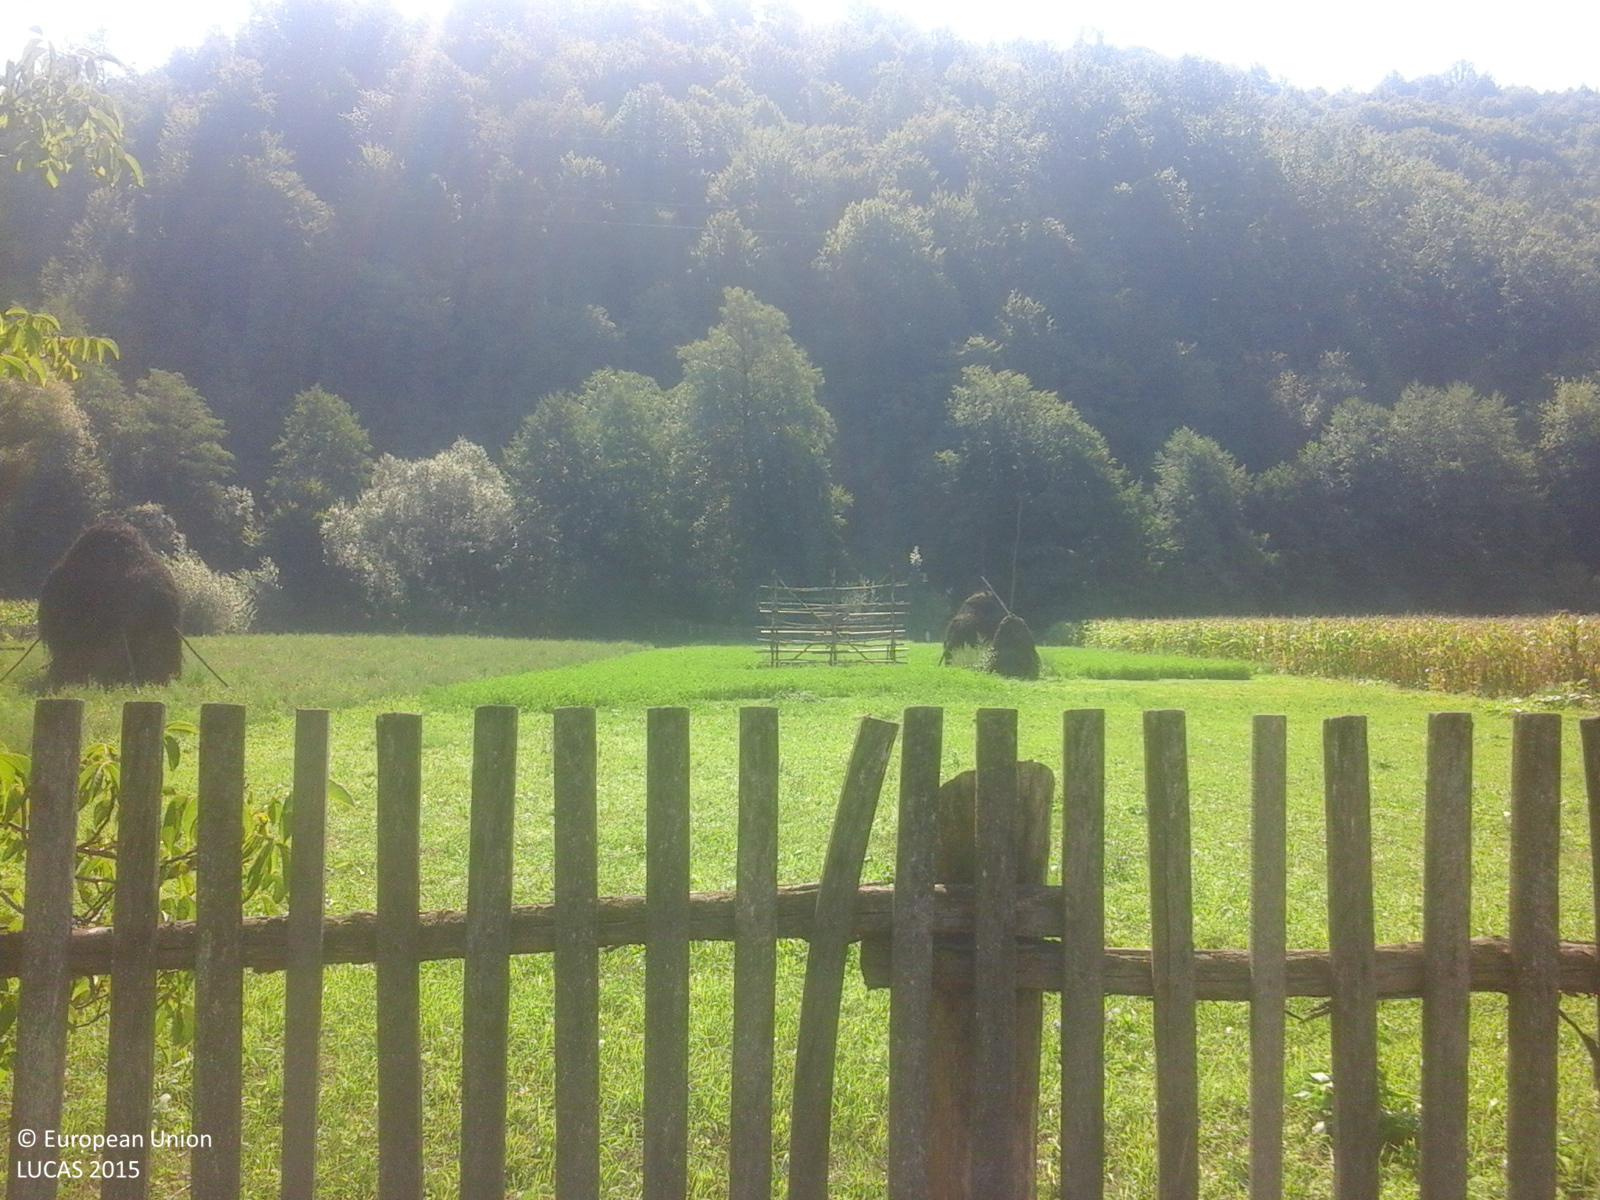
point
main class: Cropland
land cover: Lucerne
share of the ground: > 75 %
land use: Agriculture (excluding fallow land and kitchen gardens)
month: August
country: RO
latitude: 46.1176
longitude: 22.4054
